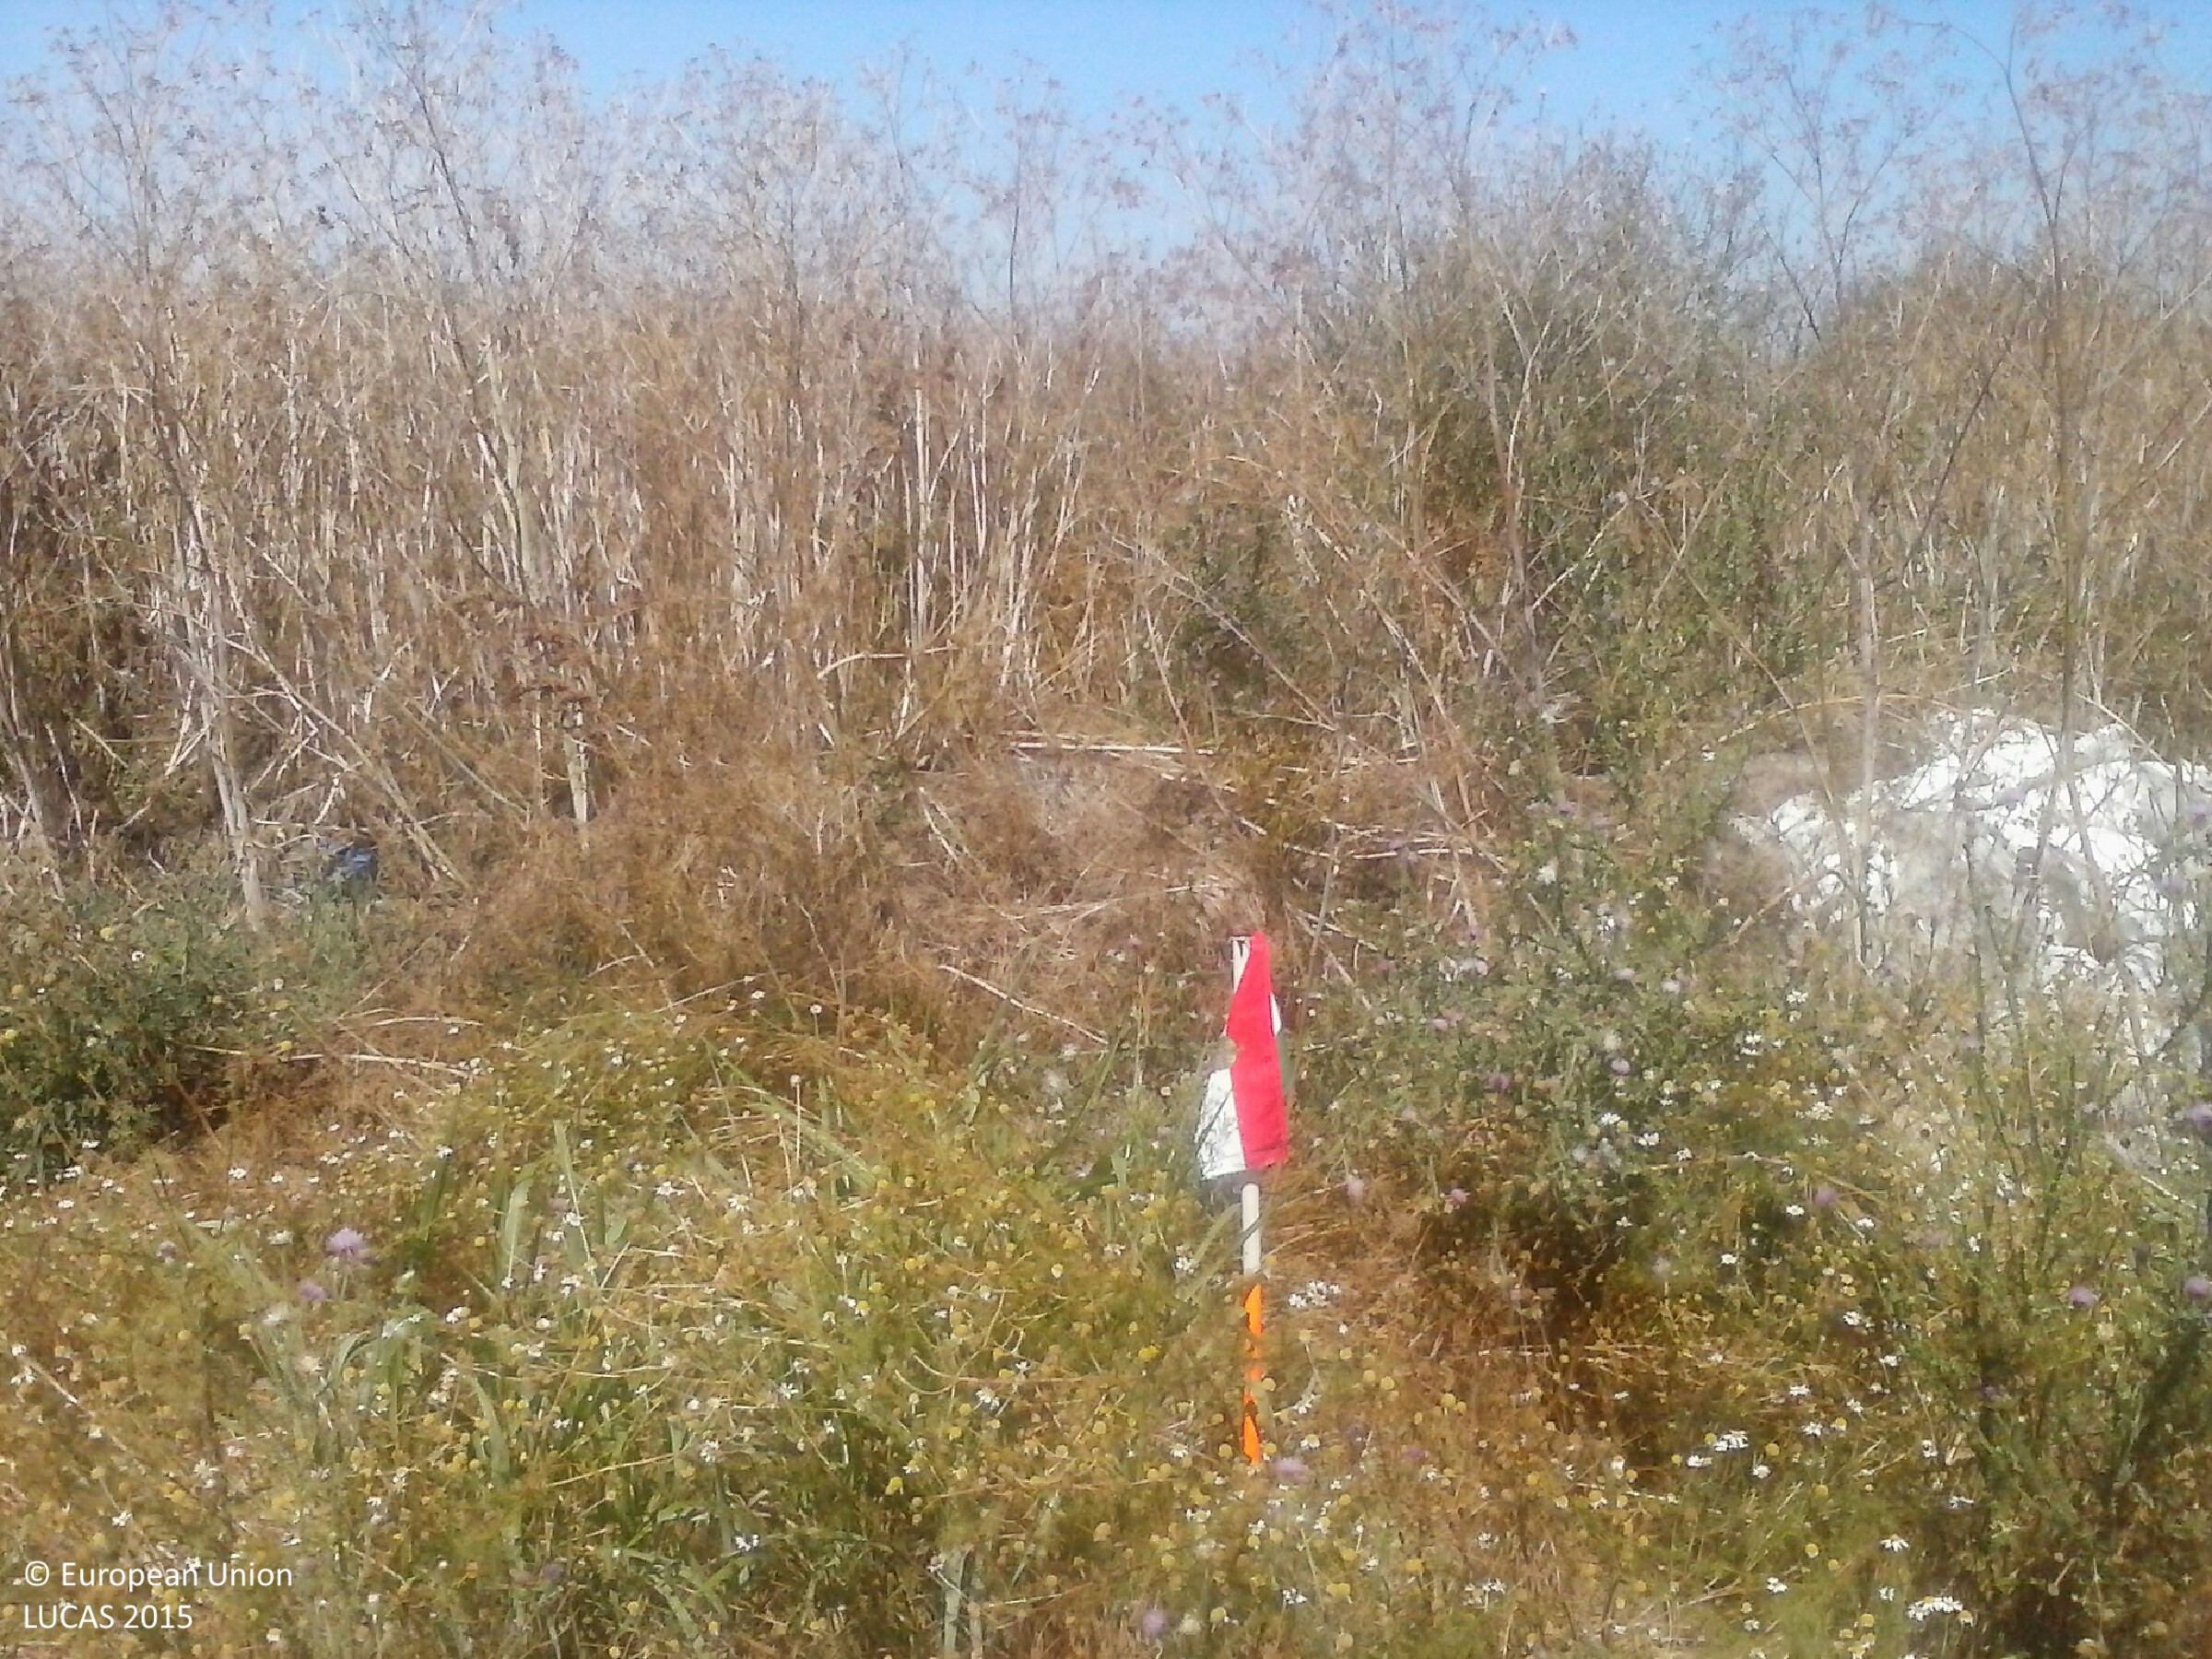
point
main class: Grassland
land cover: Spontaneously vegetated surfaces
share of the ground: 50 - 75 %
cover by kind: herbaceous plants 70 %, unconsolidated bare surface 30 %
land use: Abandoned areas
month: July
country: HU
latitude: 46.6226
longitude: 20.4086
